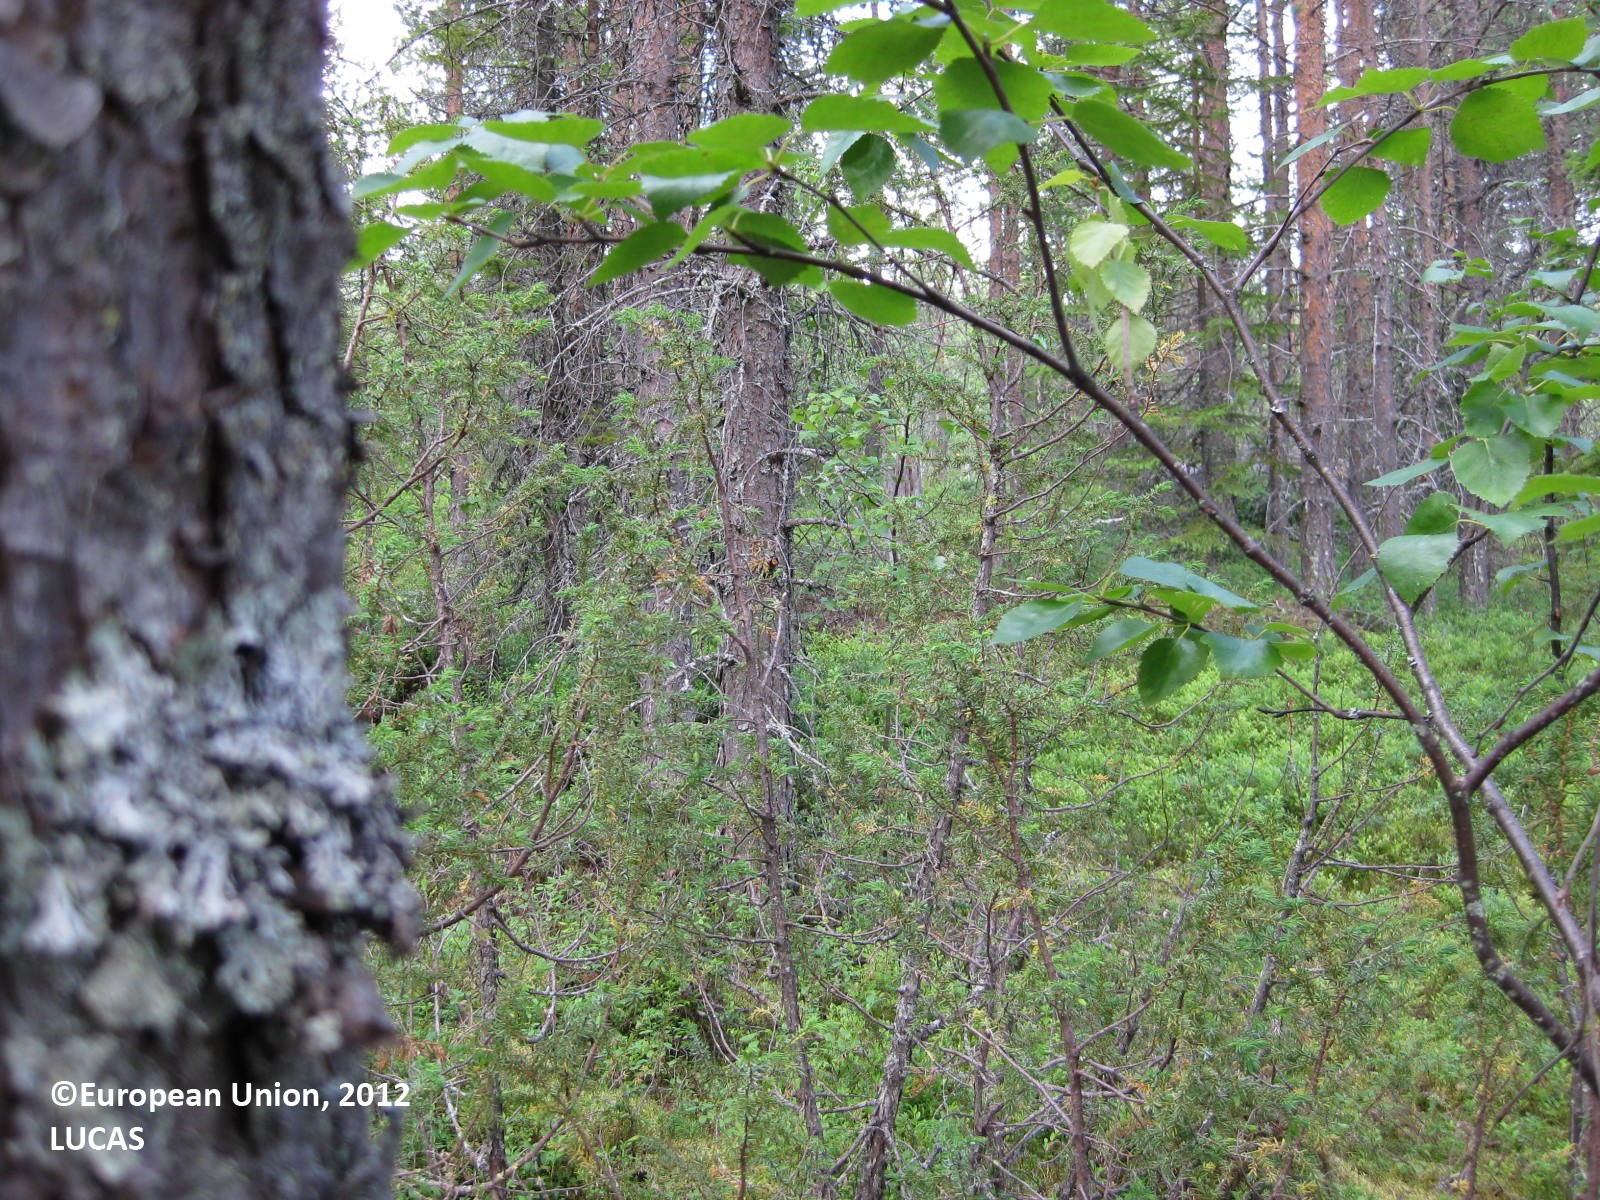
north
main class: Woodland
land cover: Pine dominated coniferous woodland
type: boreal forest
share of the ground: 50 - 75 %
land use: Forestry
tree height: > 5 m
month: July
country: FI
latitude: 65.7428
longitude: 28.5035
